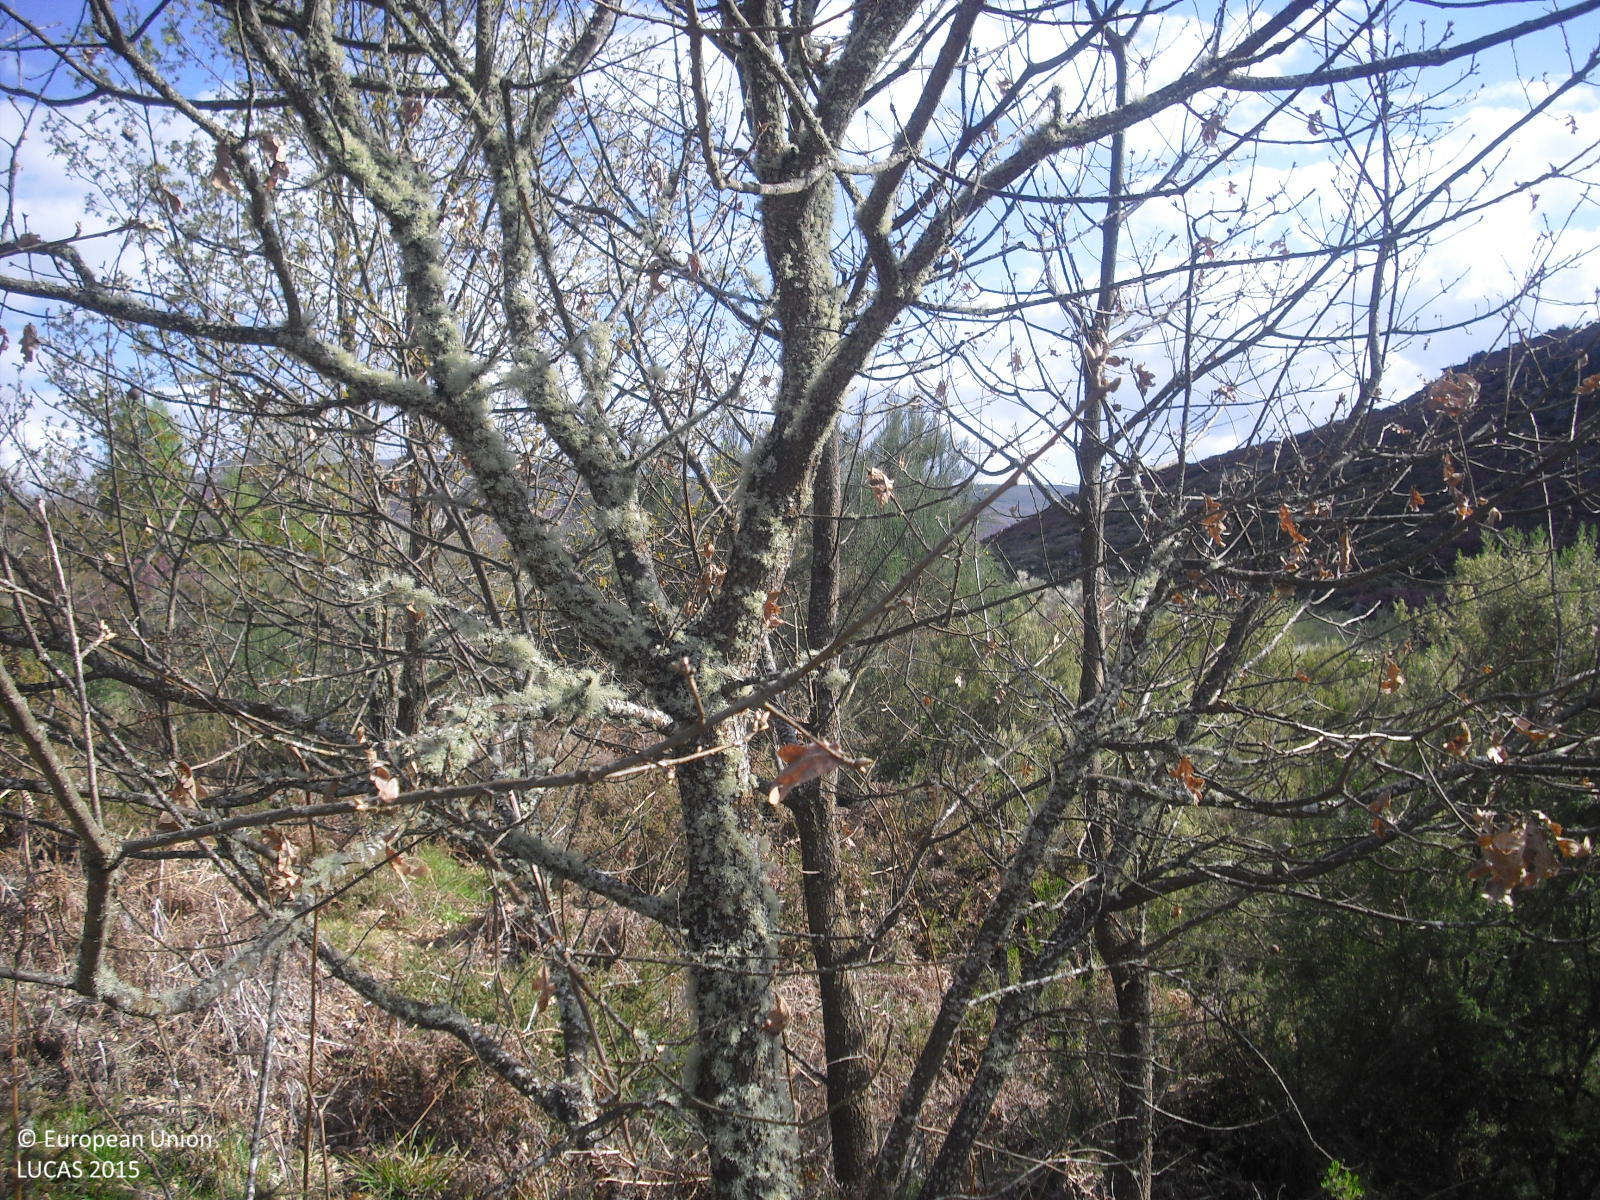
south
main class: Woodland
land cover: Broadleaved woodland
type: acidophilous oak and oak-birch forest
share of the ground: 25 - 50 %
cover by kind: shrubs 50 %, broadleaved forest trees 40 %, herbaceous plants 10 %
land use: Semi-natural and natural areas not in use
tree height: > 5 m
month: April
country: ES
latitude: 41.9193
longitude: -7.8559
